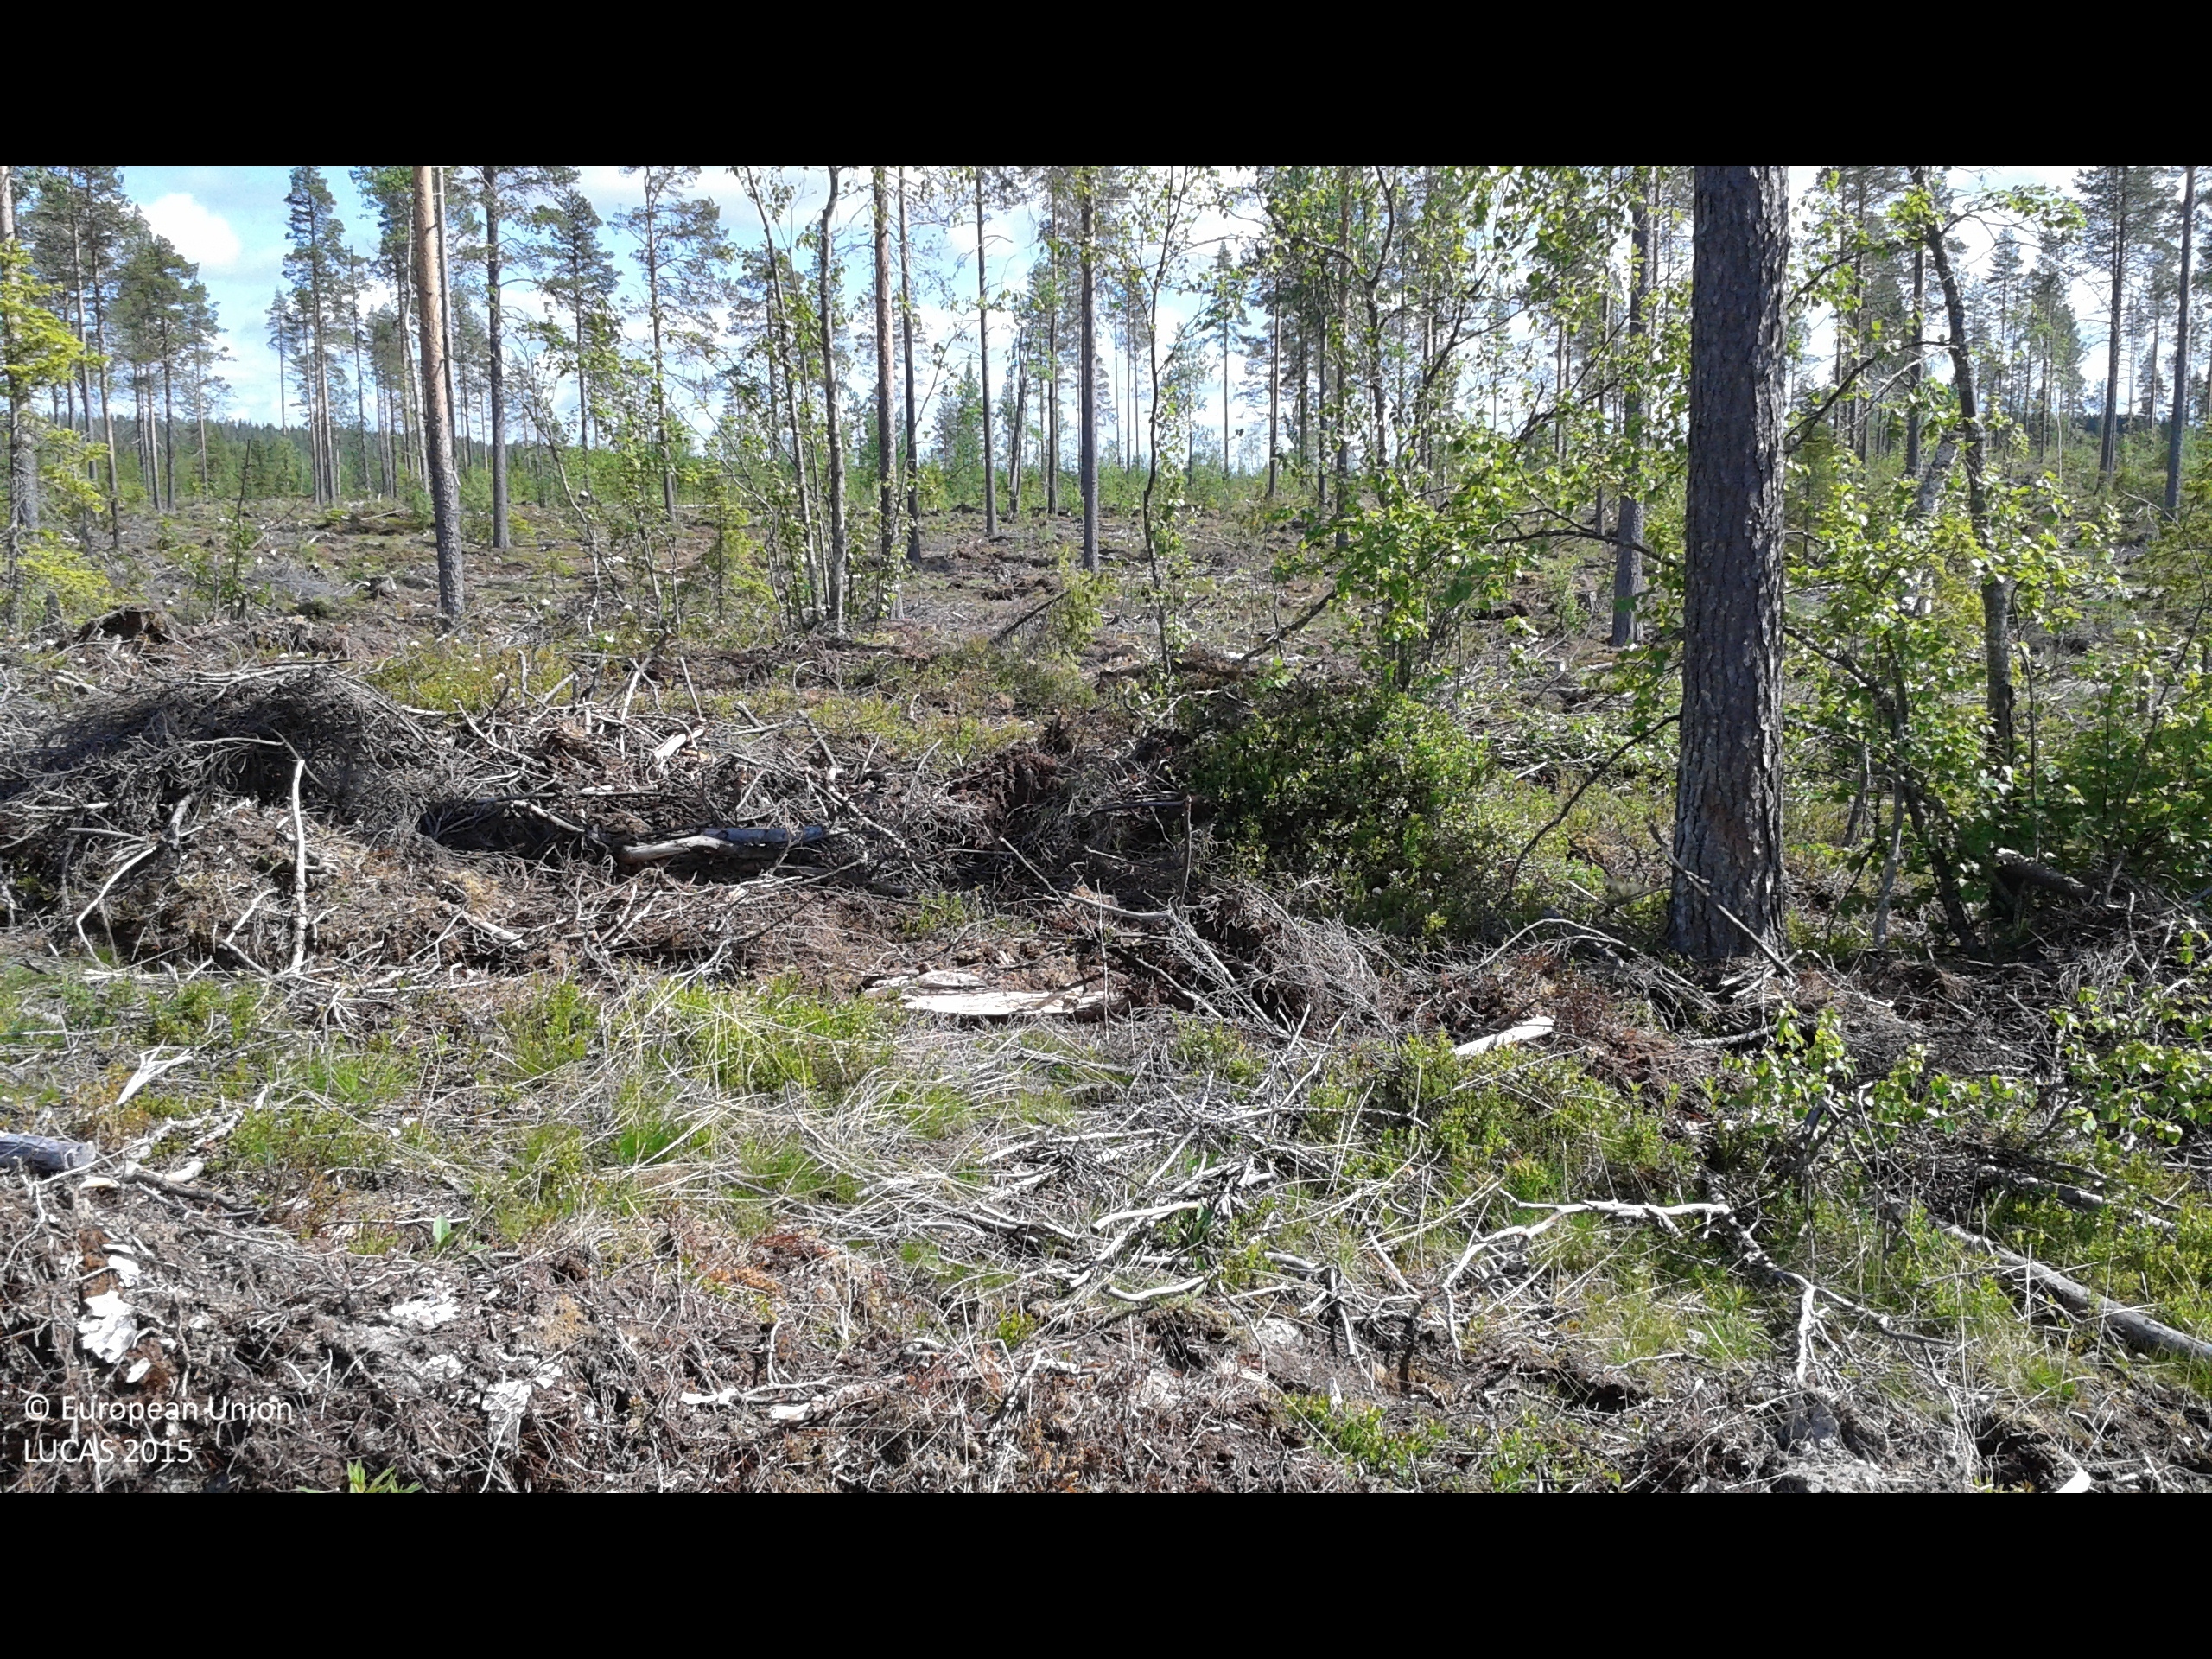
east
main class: Woodland
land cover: Pine dominated mixed woodland
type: boreal forest
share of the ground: 10 - 25 %
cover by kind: unconsolidated bare surface 50 %, shrubs 35 %, coniferous forest trees 10 %, broadleaved forest trees 5 %
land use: Forestry
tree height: > 5 m
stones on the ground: < 10 %
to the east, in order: Pine dominated mixed woodland; Broadleaved woodland; Other mixed woodland; Pine dominated mixed woodland
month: July
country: SE
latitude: 67.0349
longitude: 23.0854
